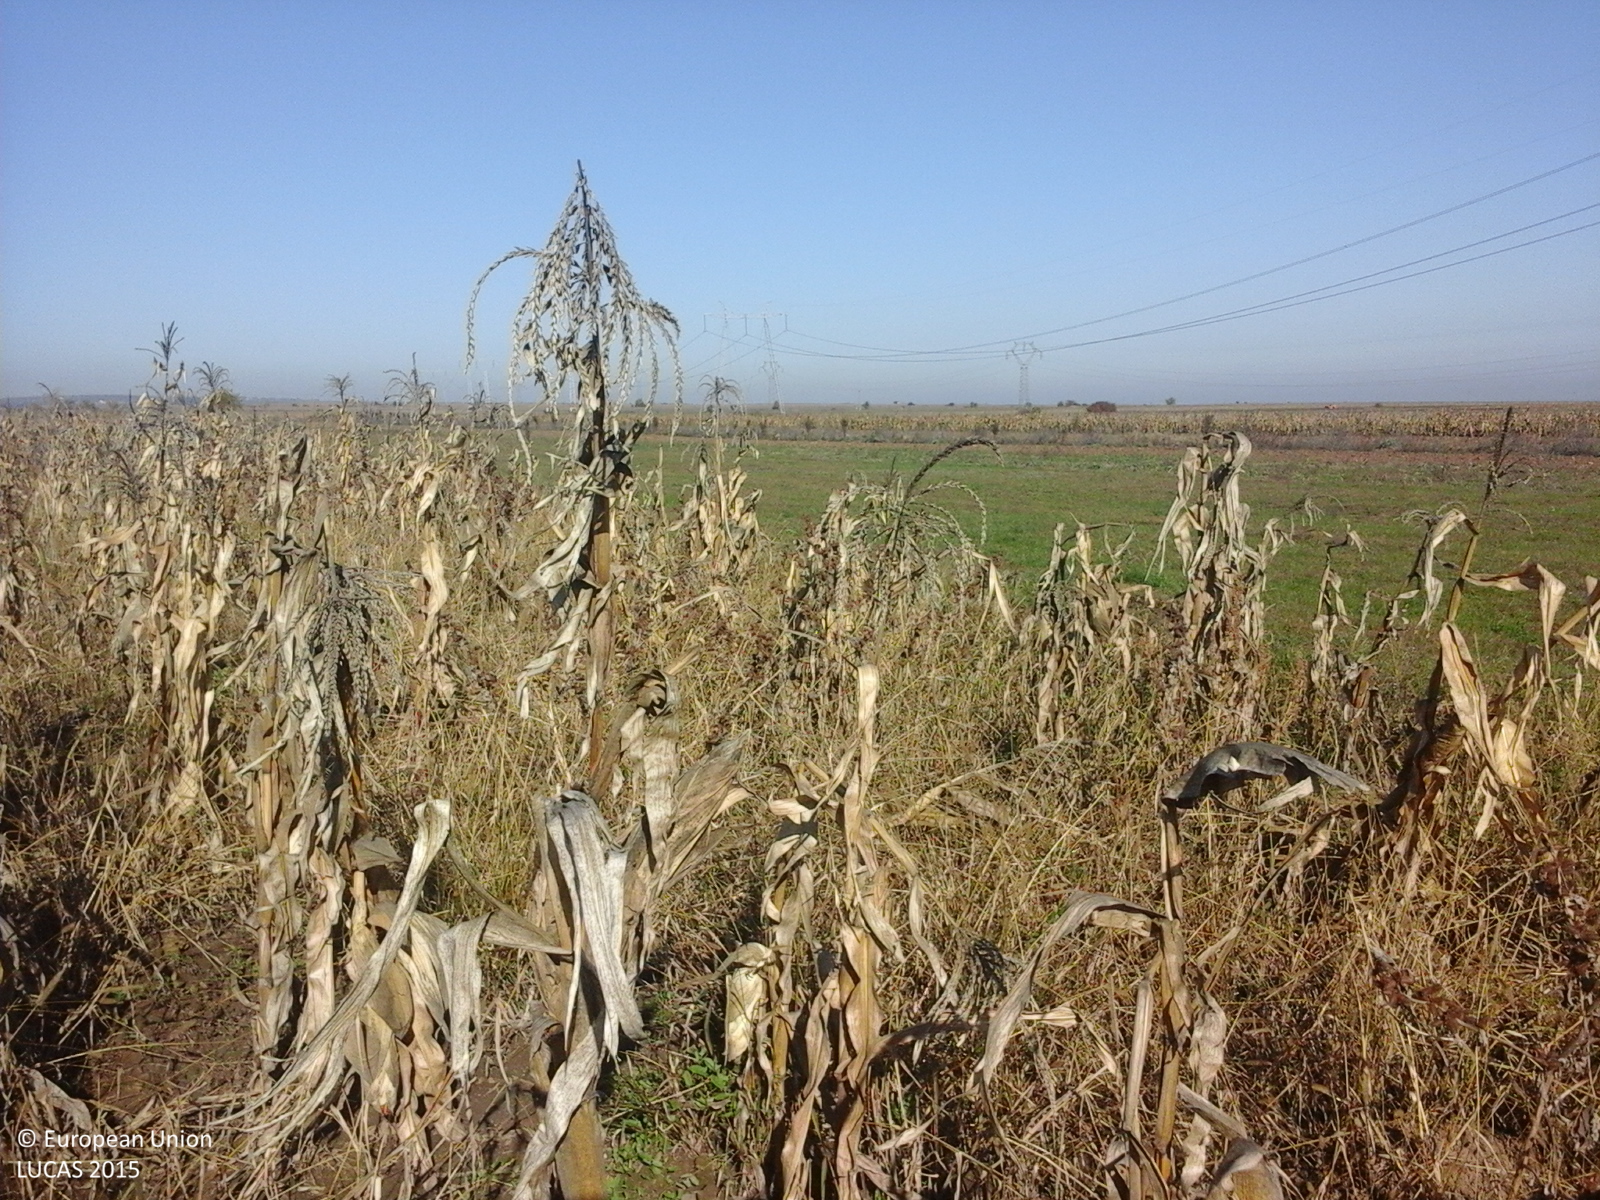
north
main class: Cropland
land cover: Maize
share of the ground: > 75 %
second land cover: Spontaneously vegetated surfaces
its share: 50 - 75 %
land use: Agriculture (excluding fallow land and kitchen gardens)
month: October
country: RO
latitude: 45.9658
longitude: 27.1427
